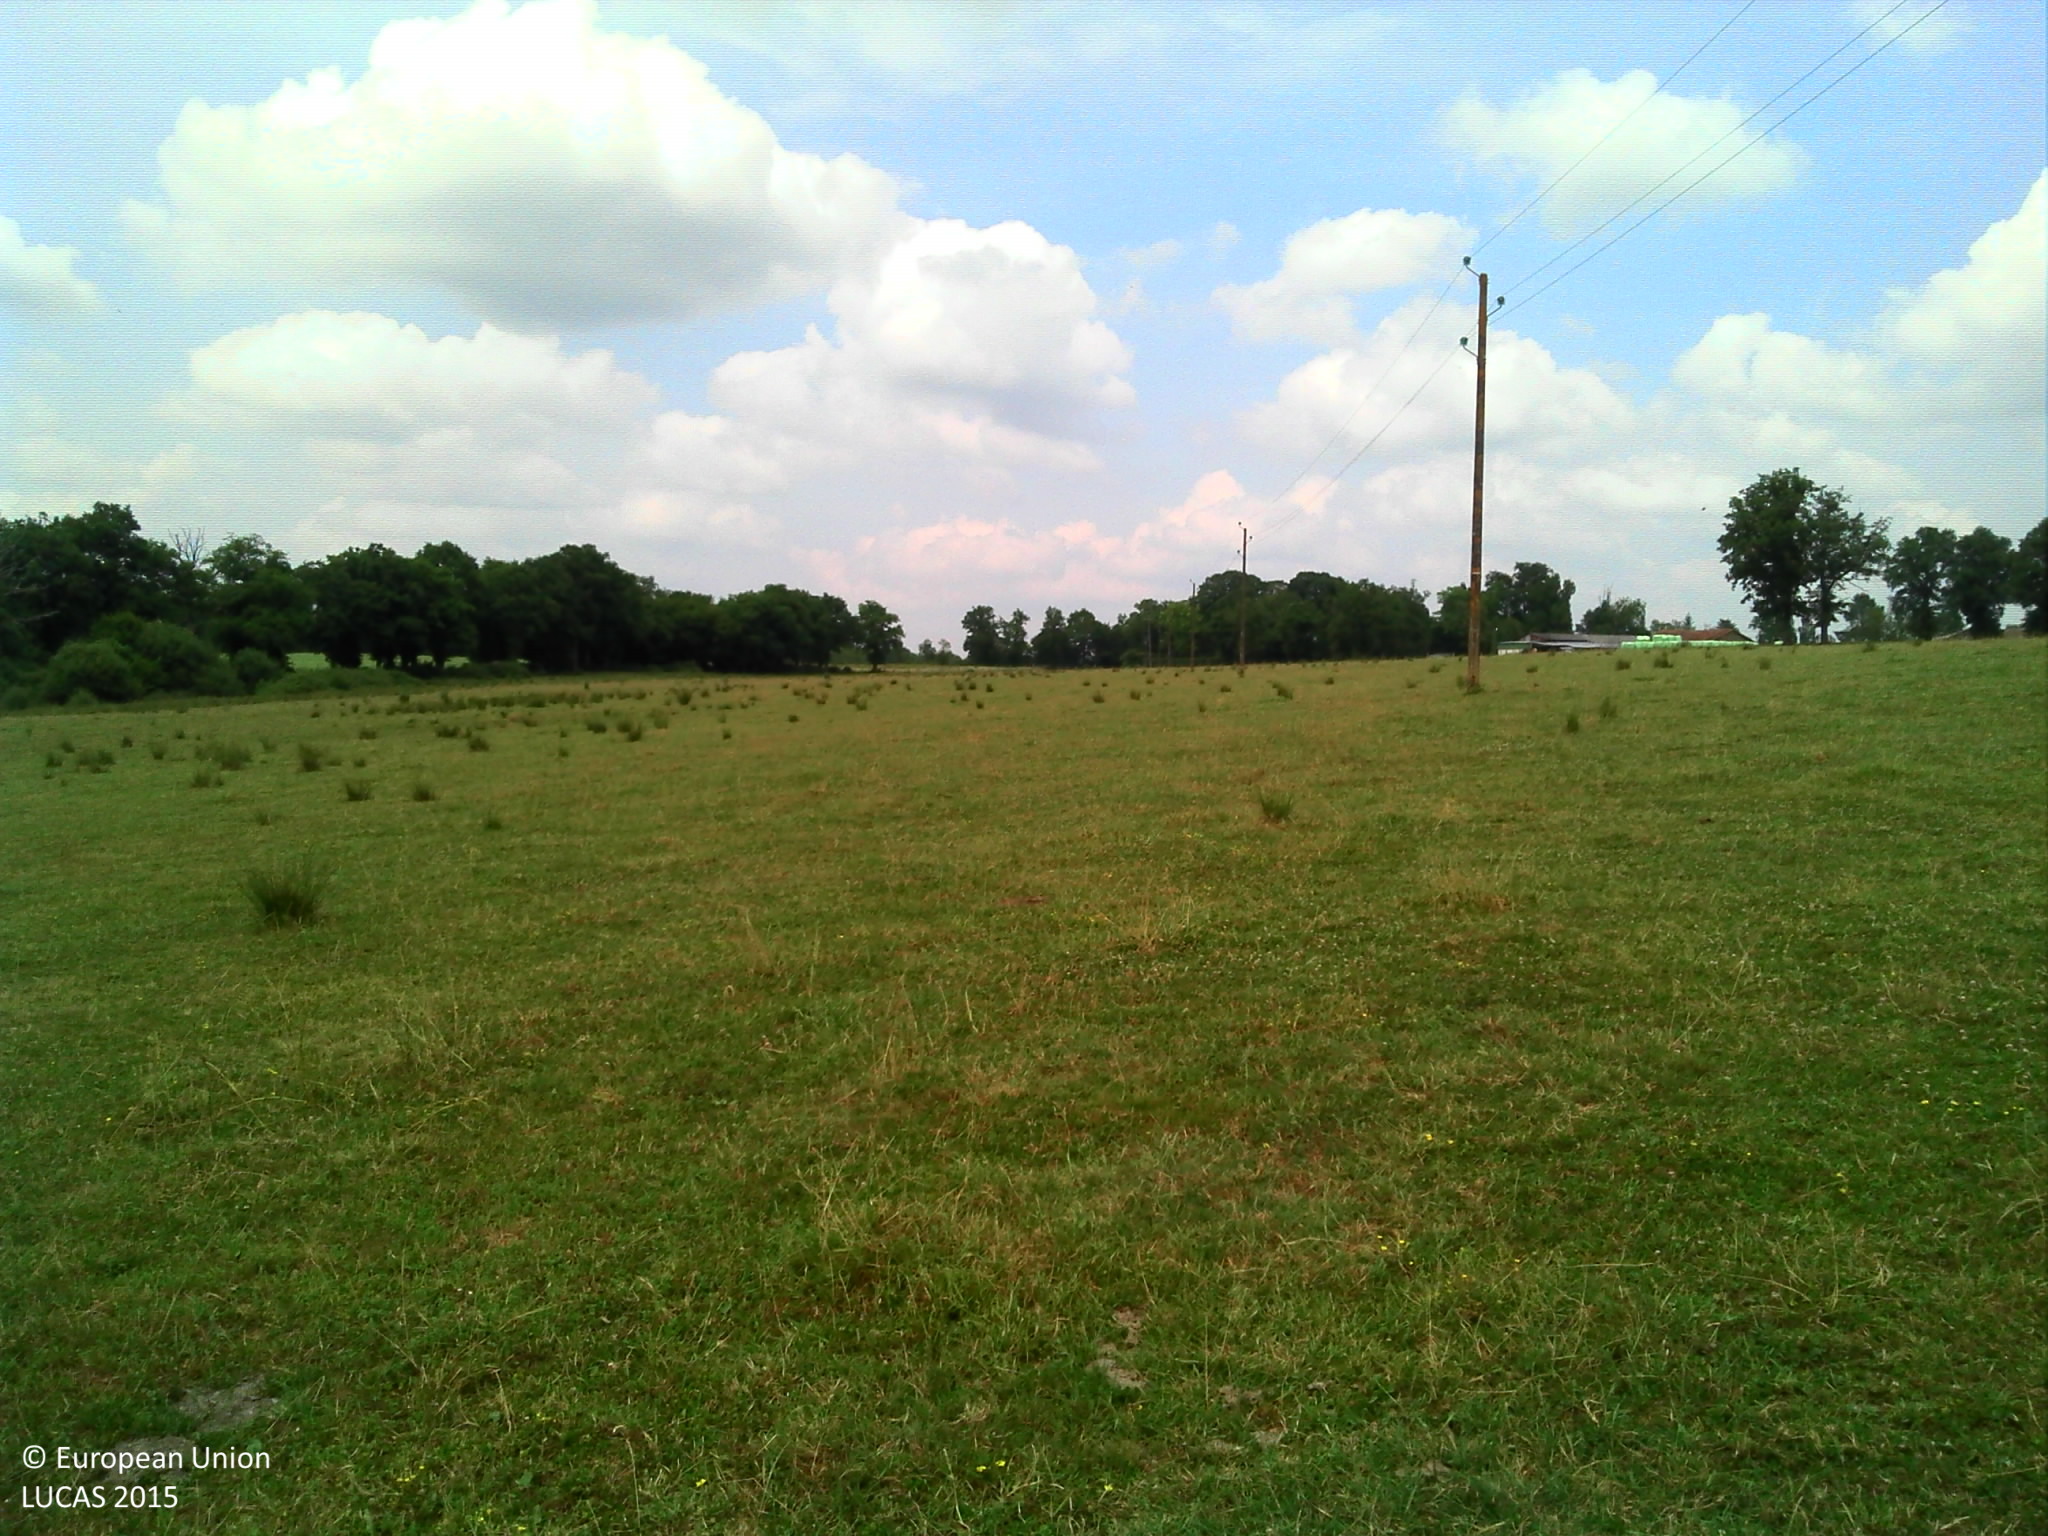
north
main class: Grassland
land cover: Grassland without tree/shrub cover
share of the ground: > 75 %
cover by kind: herbaceous plants 100 %
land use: Agriculture (excluding fallow land and kitchen gardens)
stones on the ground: < 10 %
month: June
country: FR
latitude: 46.0109
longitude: 0.6223
